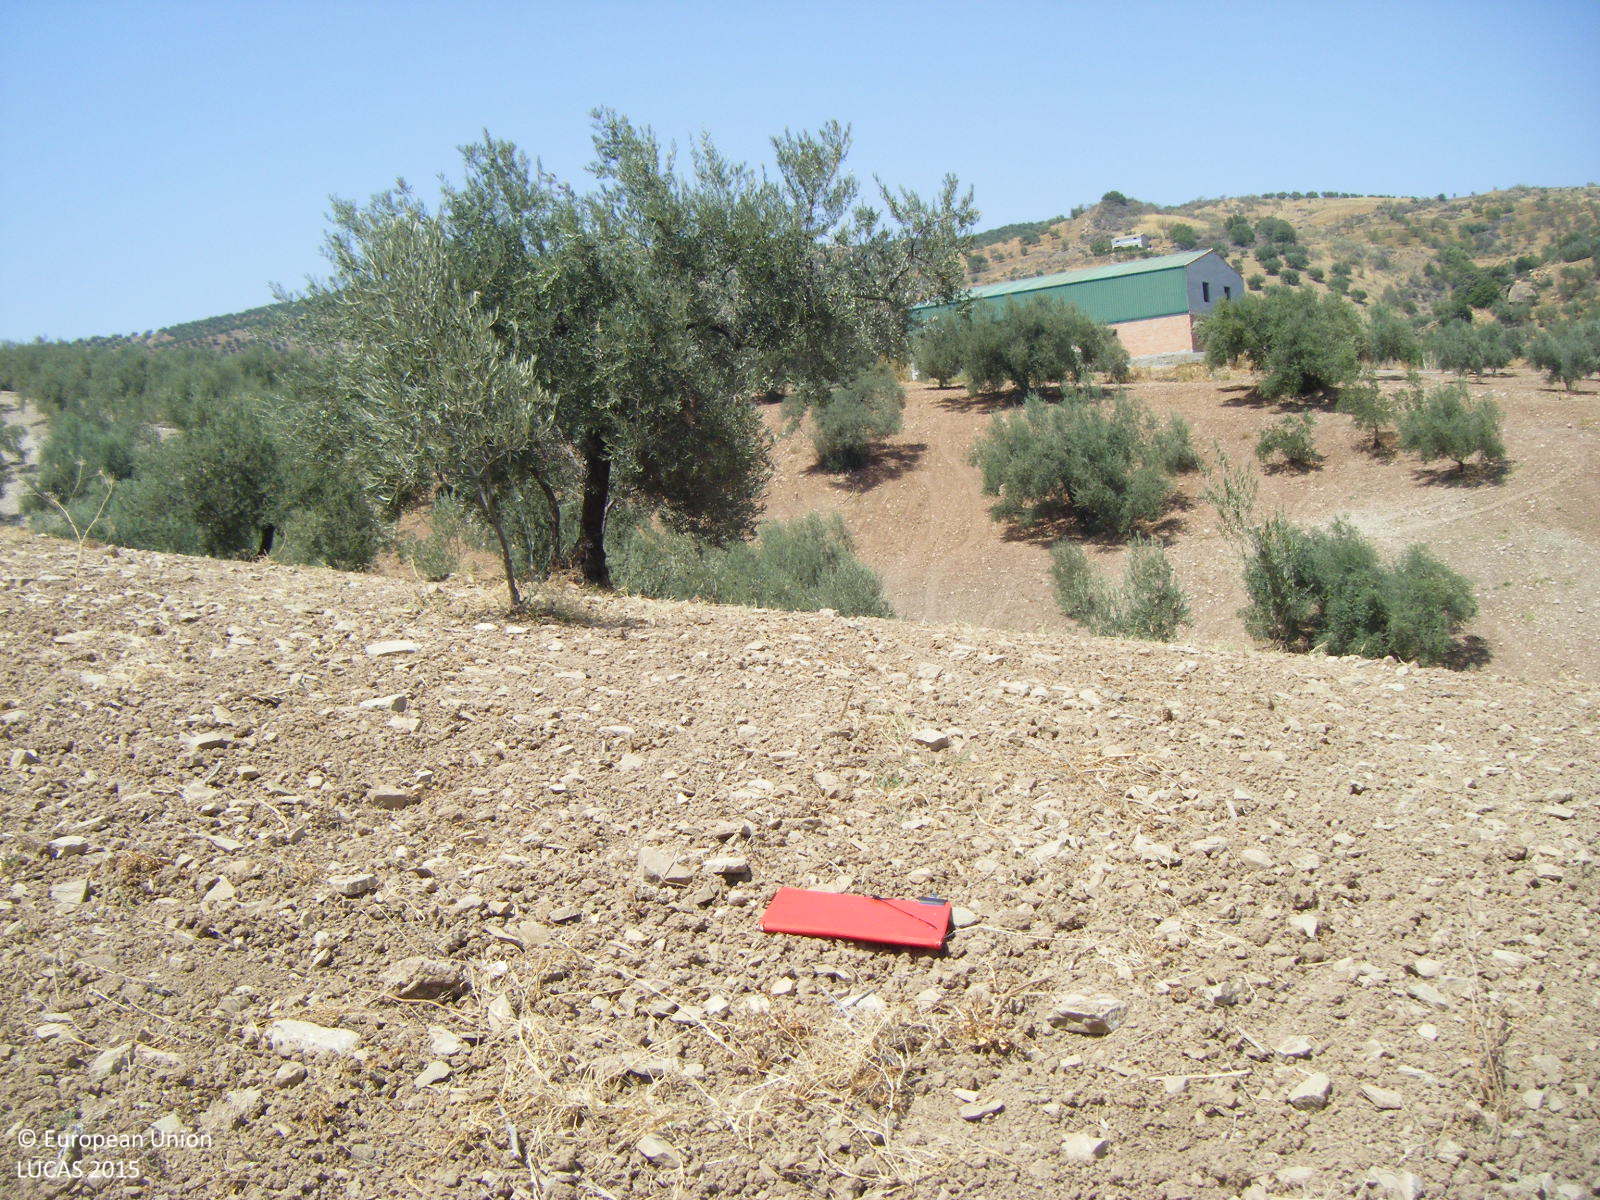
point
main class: Cropland
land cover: Olive groves
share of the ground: 10 - 25 %
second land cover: Other bare soil
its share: > 75 %
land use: Agriculture (excluding fallow land and kitchen gardens)
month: July
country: ES
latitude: 36.8887
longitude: -4.2524
